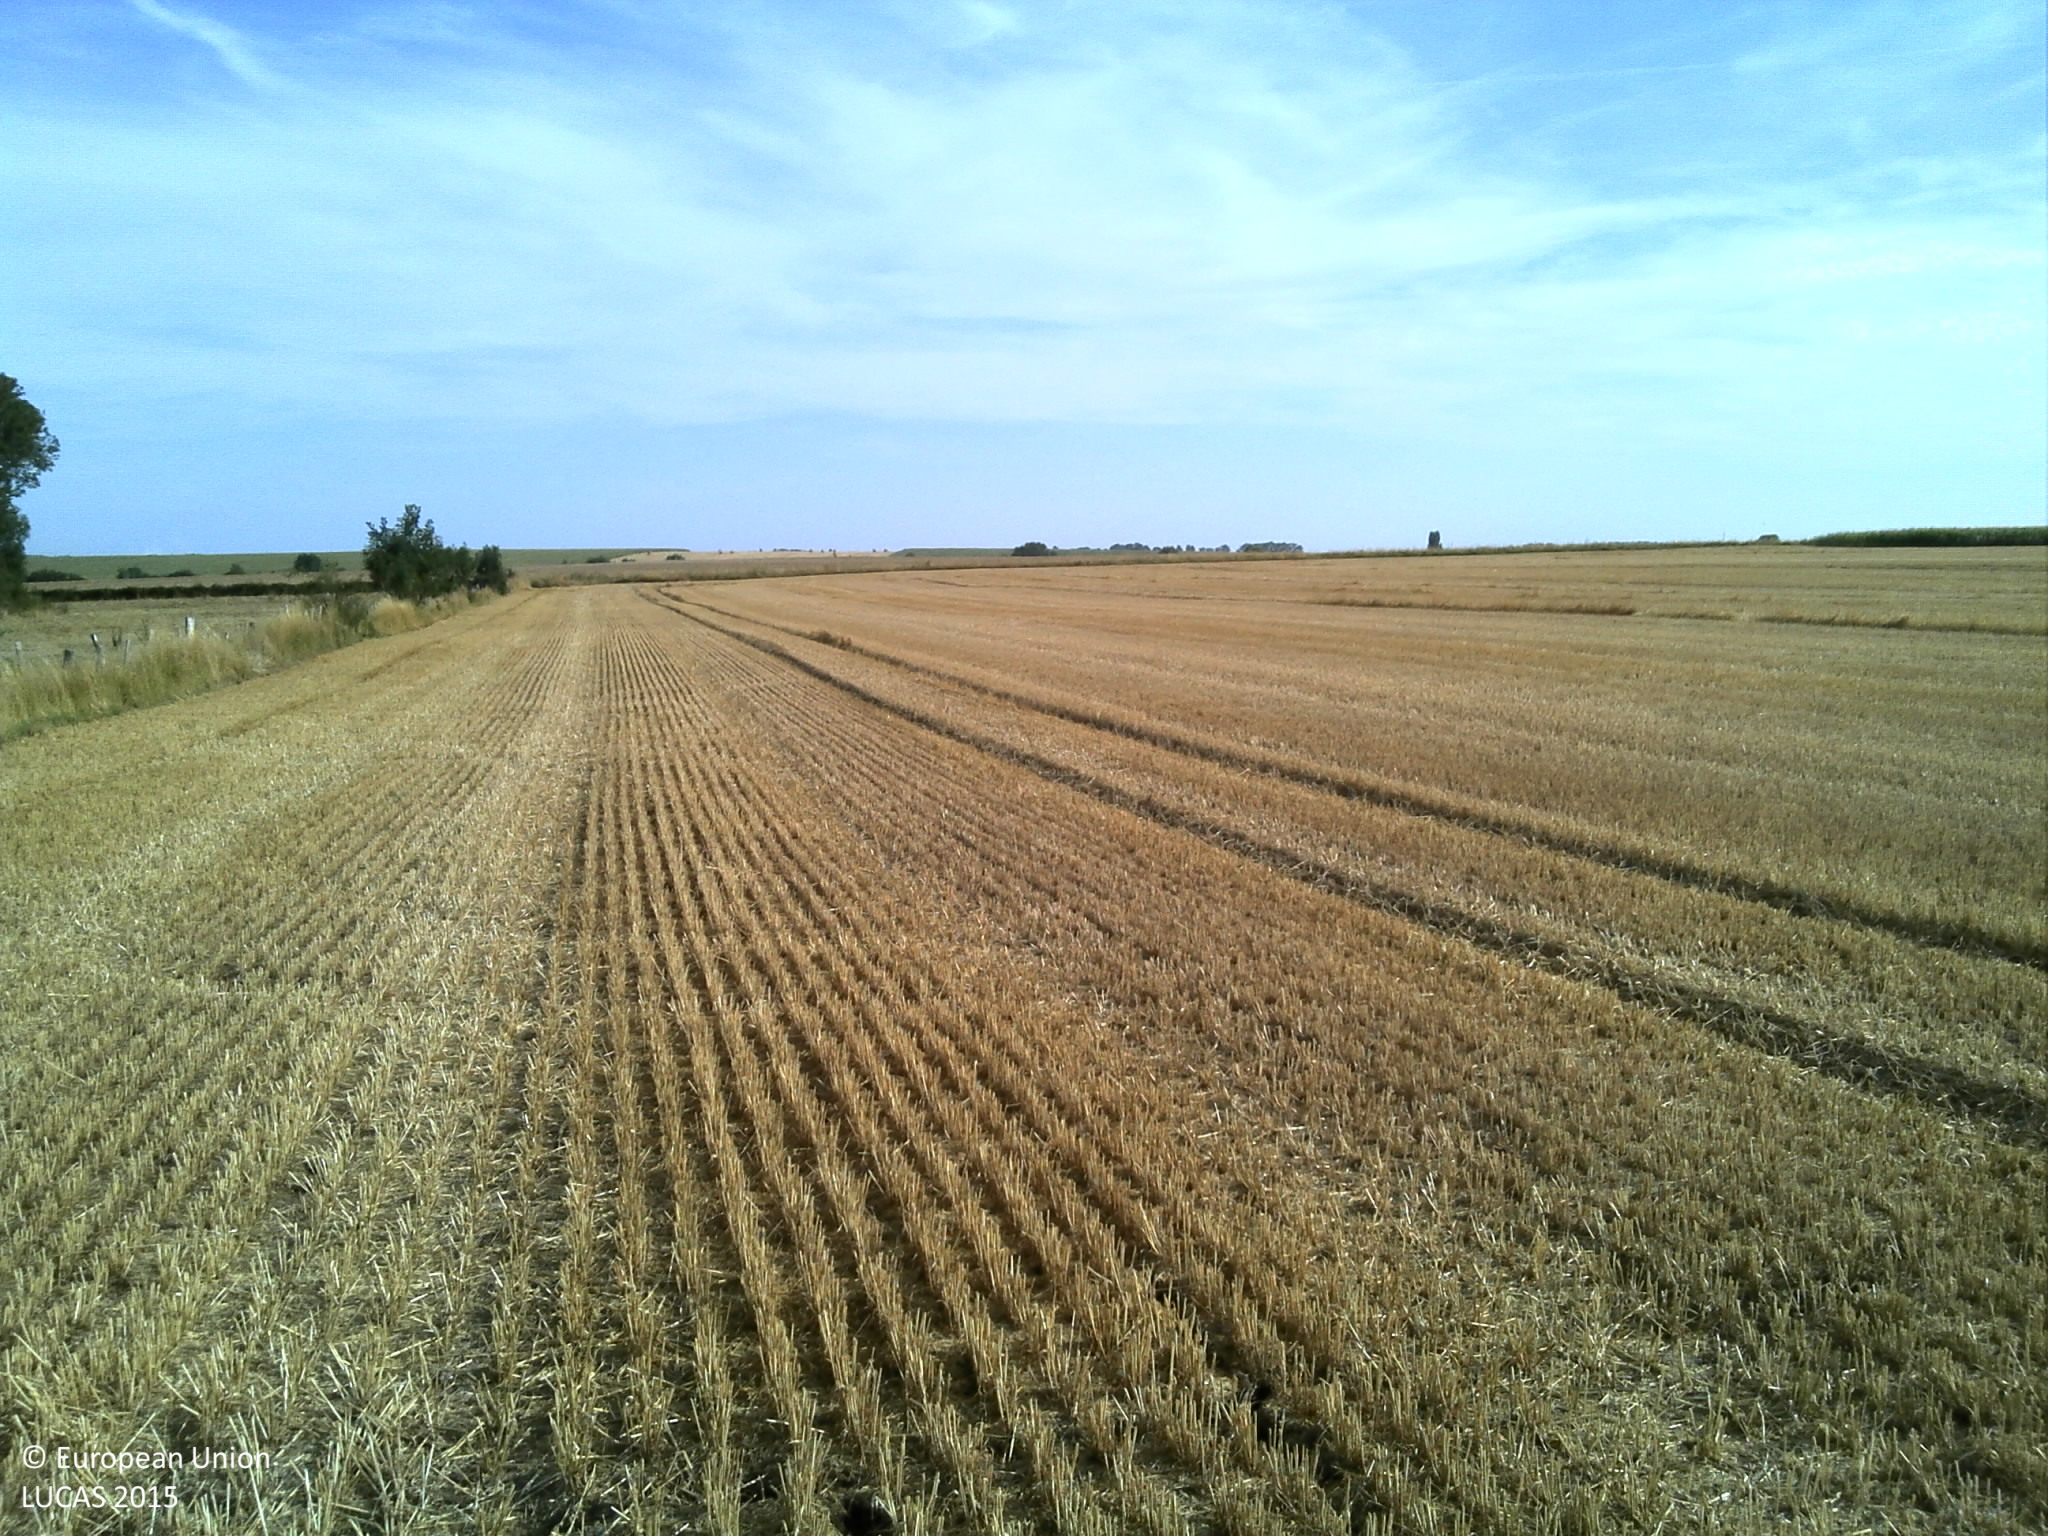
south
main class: Cropland
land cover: Common wheat
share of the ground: > 75 %
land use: Agriculture (excluding fallow land and kitchen gardens)
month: August
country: FR
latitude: 48.9493
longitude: 4.8223
